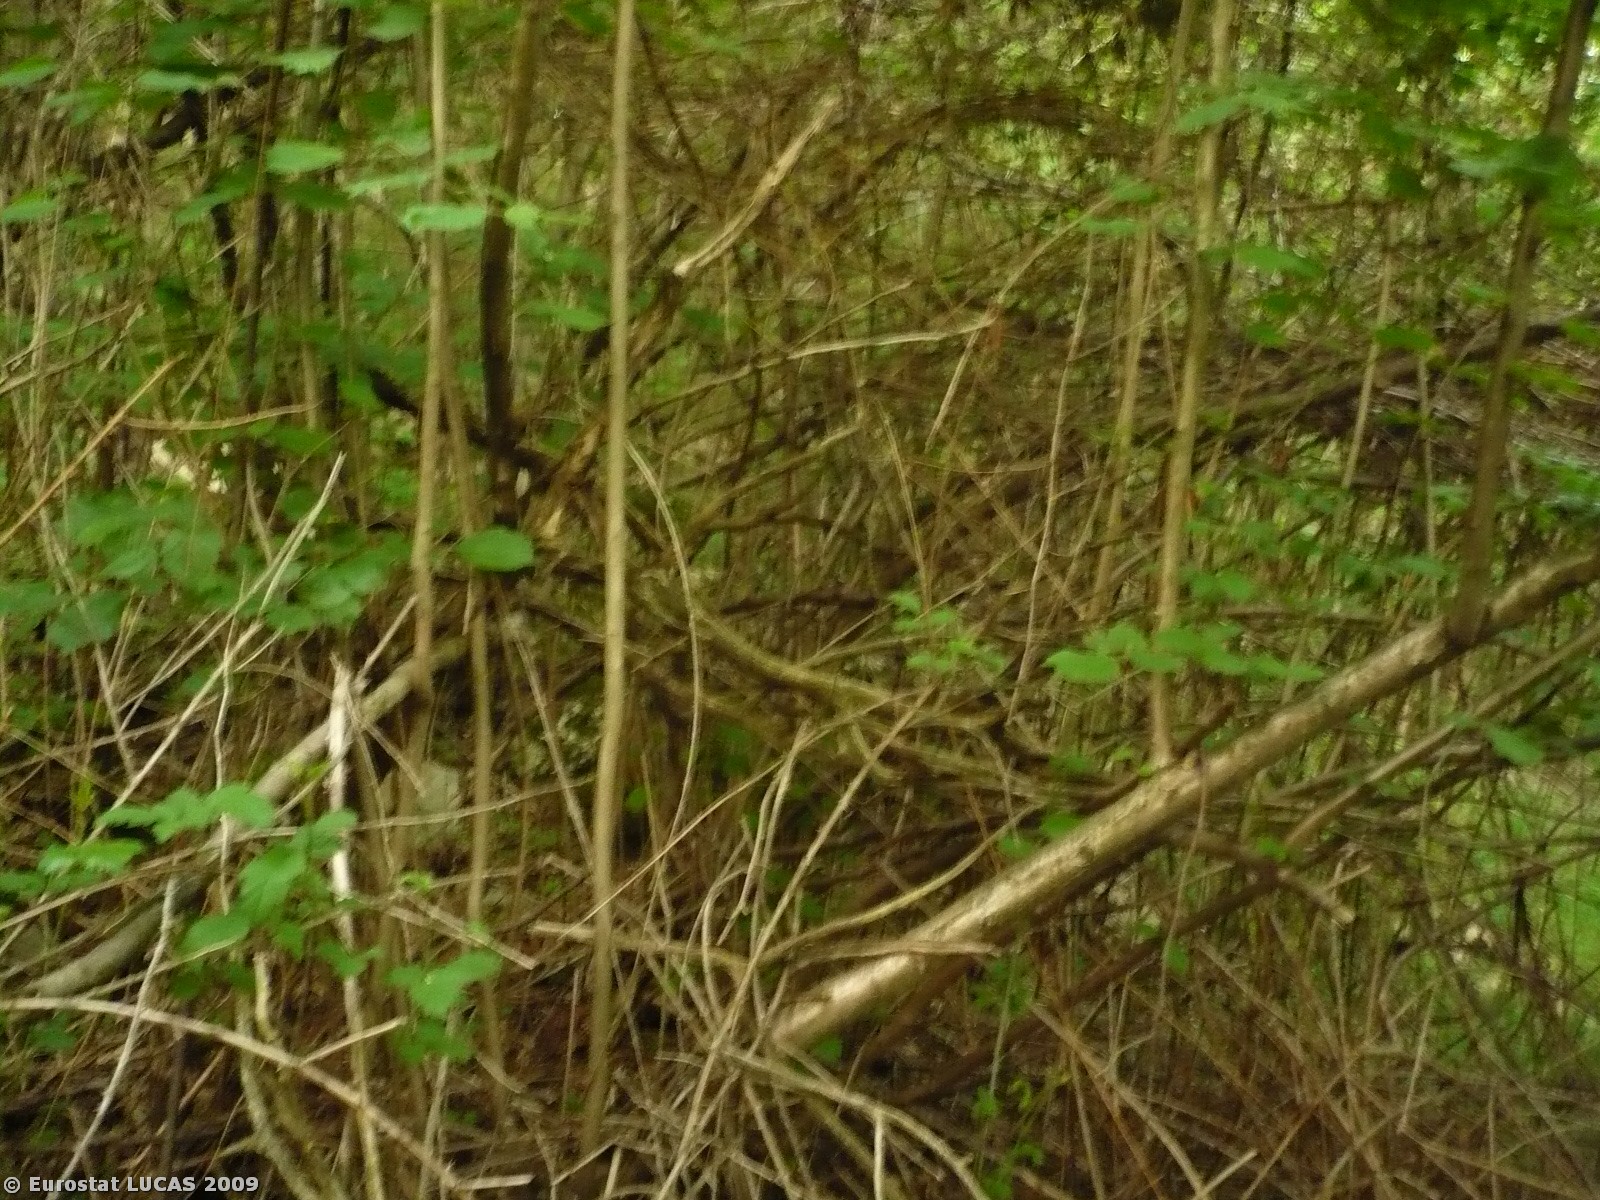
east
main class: Woodland
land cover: Broadleaved woodland
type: thermophilous deciduous forest
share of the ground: > 75 %
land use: Agriculture (excluding fallow land and kitchen gardens)
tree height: > 5 m
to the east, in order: Broadleaved woodland; Fences; Grass margins; Paved roads, cycling and walking lanes; Grass margins; Abandoned hedges; Fences; Tracks; Broadleaved woodland; Tracks; Grassland with sparse tree/shrub cover; Fences; Dry stone walls; Shrubland with sparse tree cover; Grassland with sparse tree/shrub cover; Fences; Grassland with sparse tree/shrub cover
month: May
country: SI
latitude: 46.0535
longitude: 13.6799
